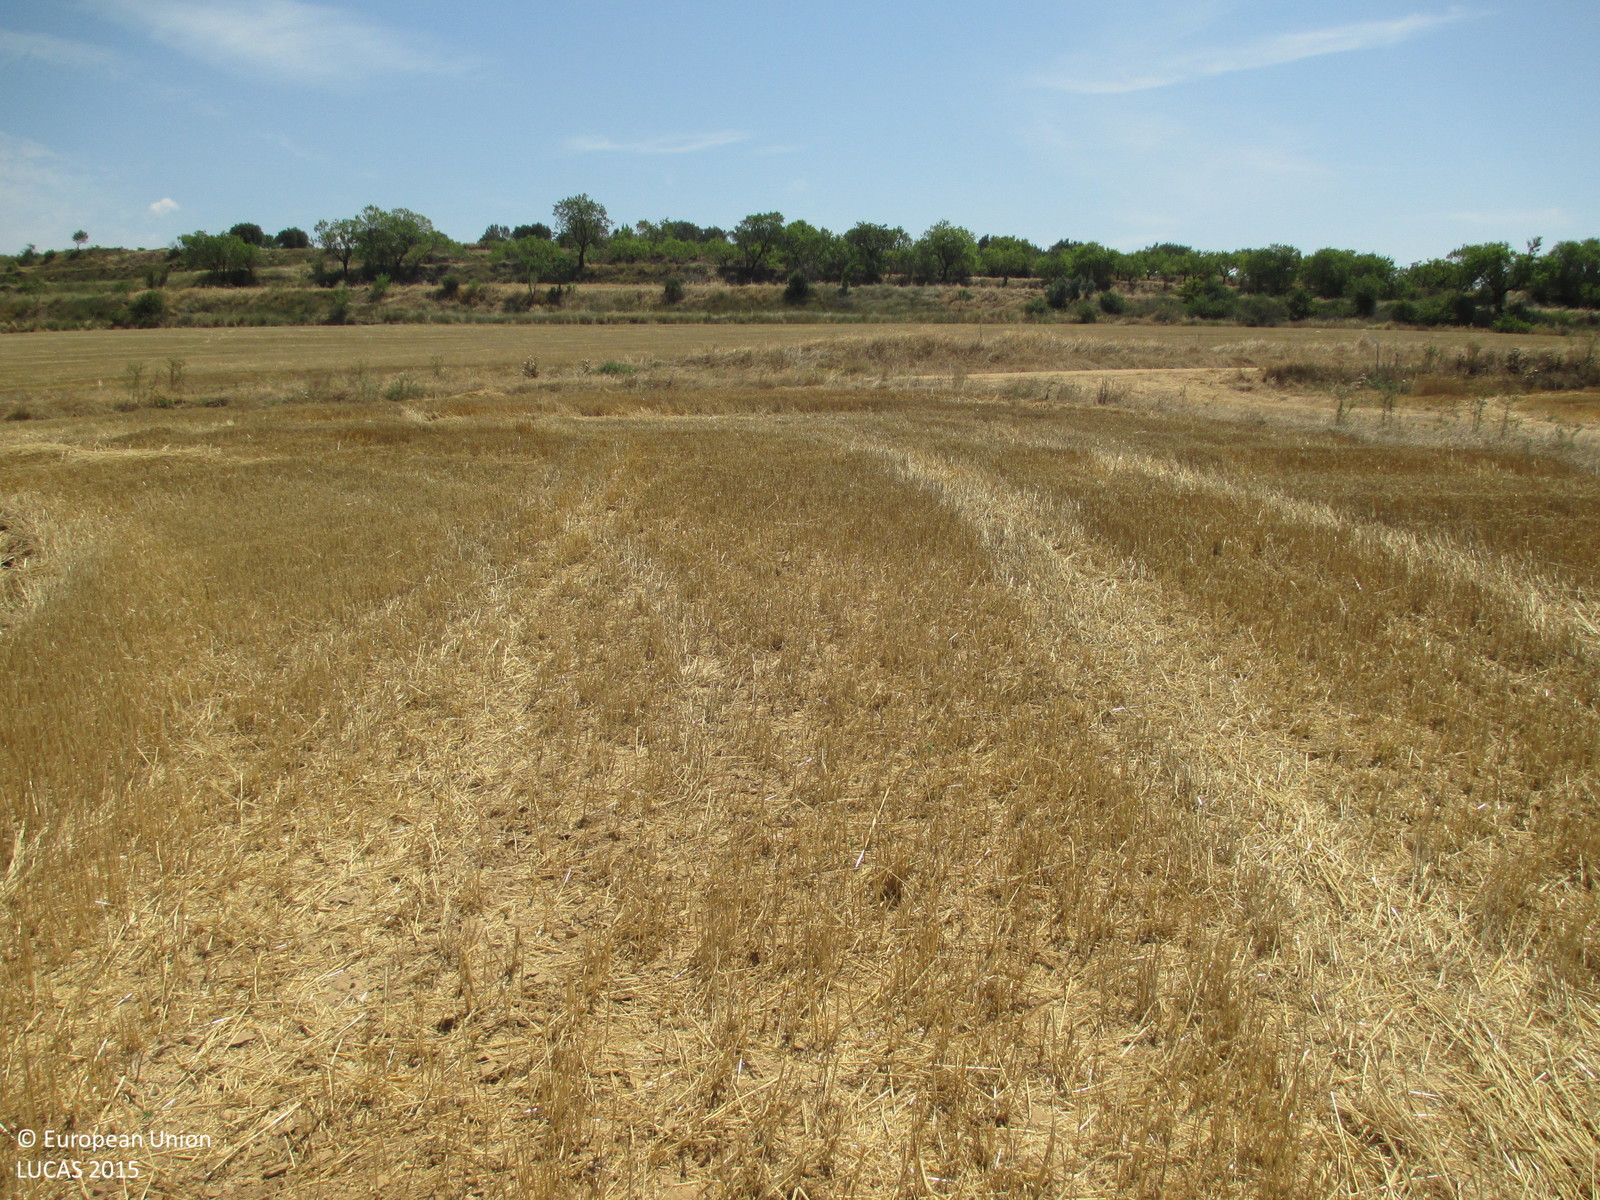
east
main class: Cropland
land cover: Common wheat
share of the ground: < 10 %
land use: Agriculture (excluding fallow land and kitchen gardens)
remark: Harvested field
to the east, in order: Common wheat; Shruby margins; Tracks; Shruby margins; Barley; Shrubland with sparse tree cover; Common wheat; Dry stone walls; Lines of trees; Shruby margins; Nuts trees; Shruby margins; Olive groves; Grass margins; Olive groves; Common wheat
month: June
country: ES
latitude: 42.2054
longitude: -0.4273
